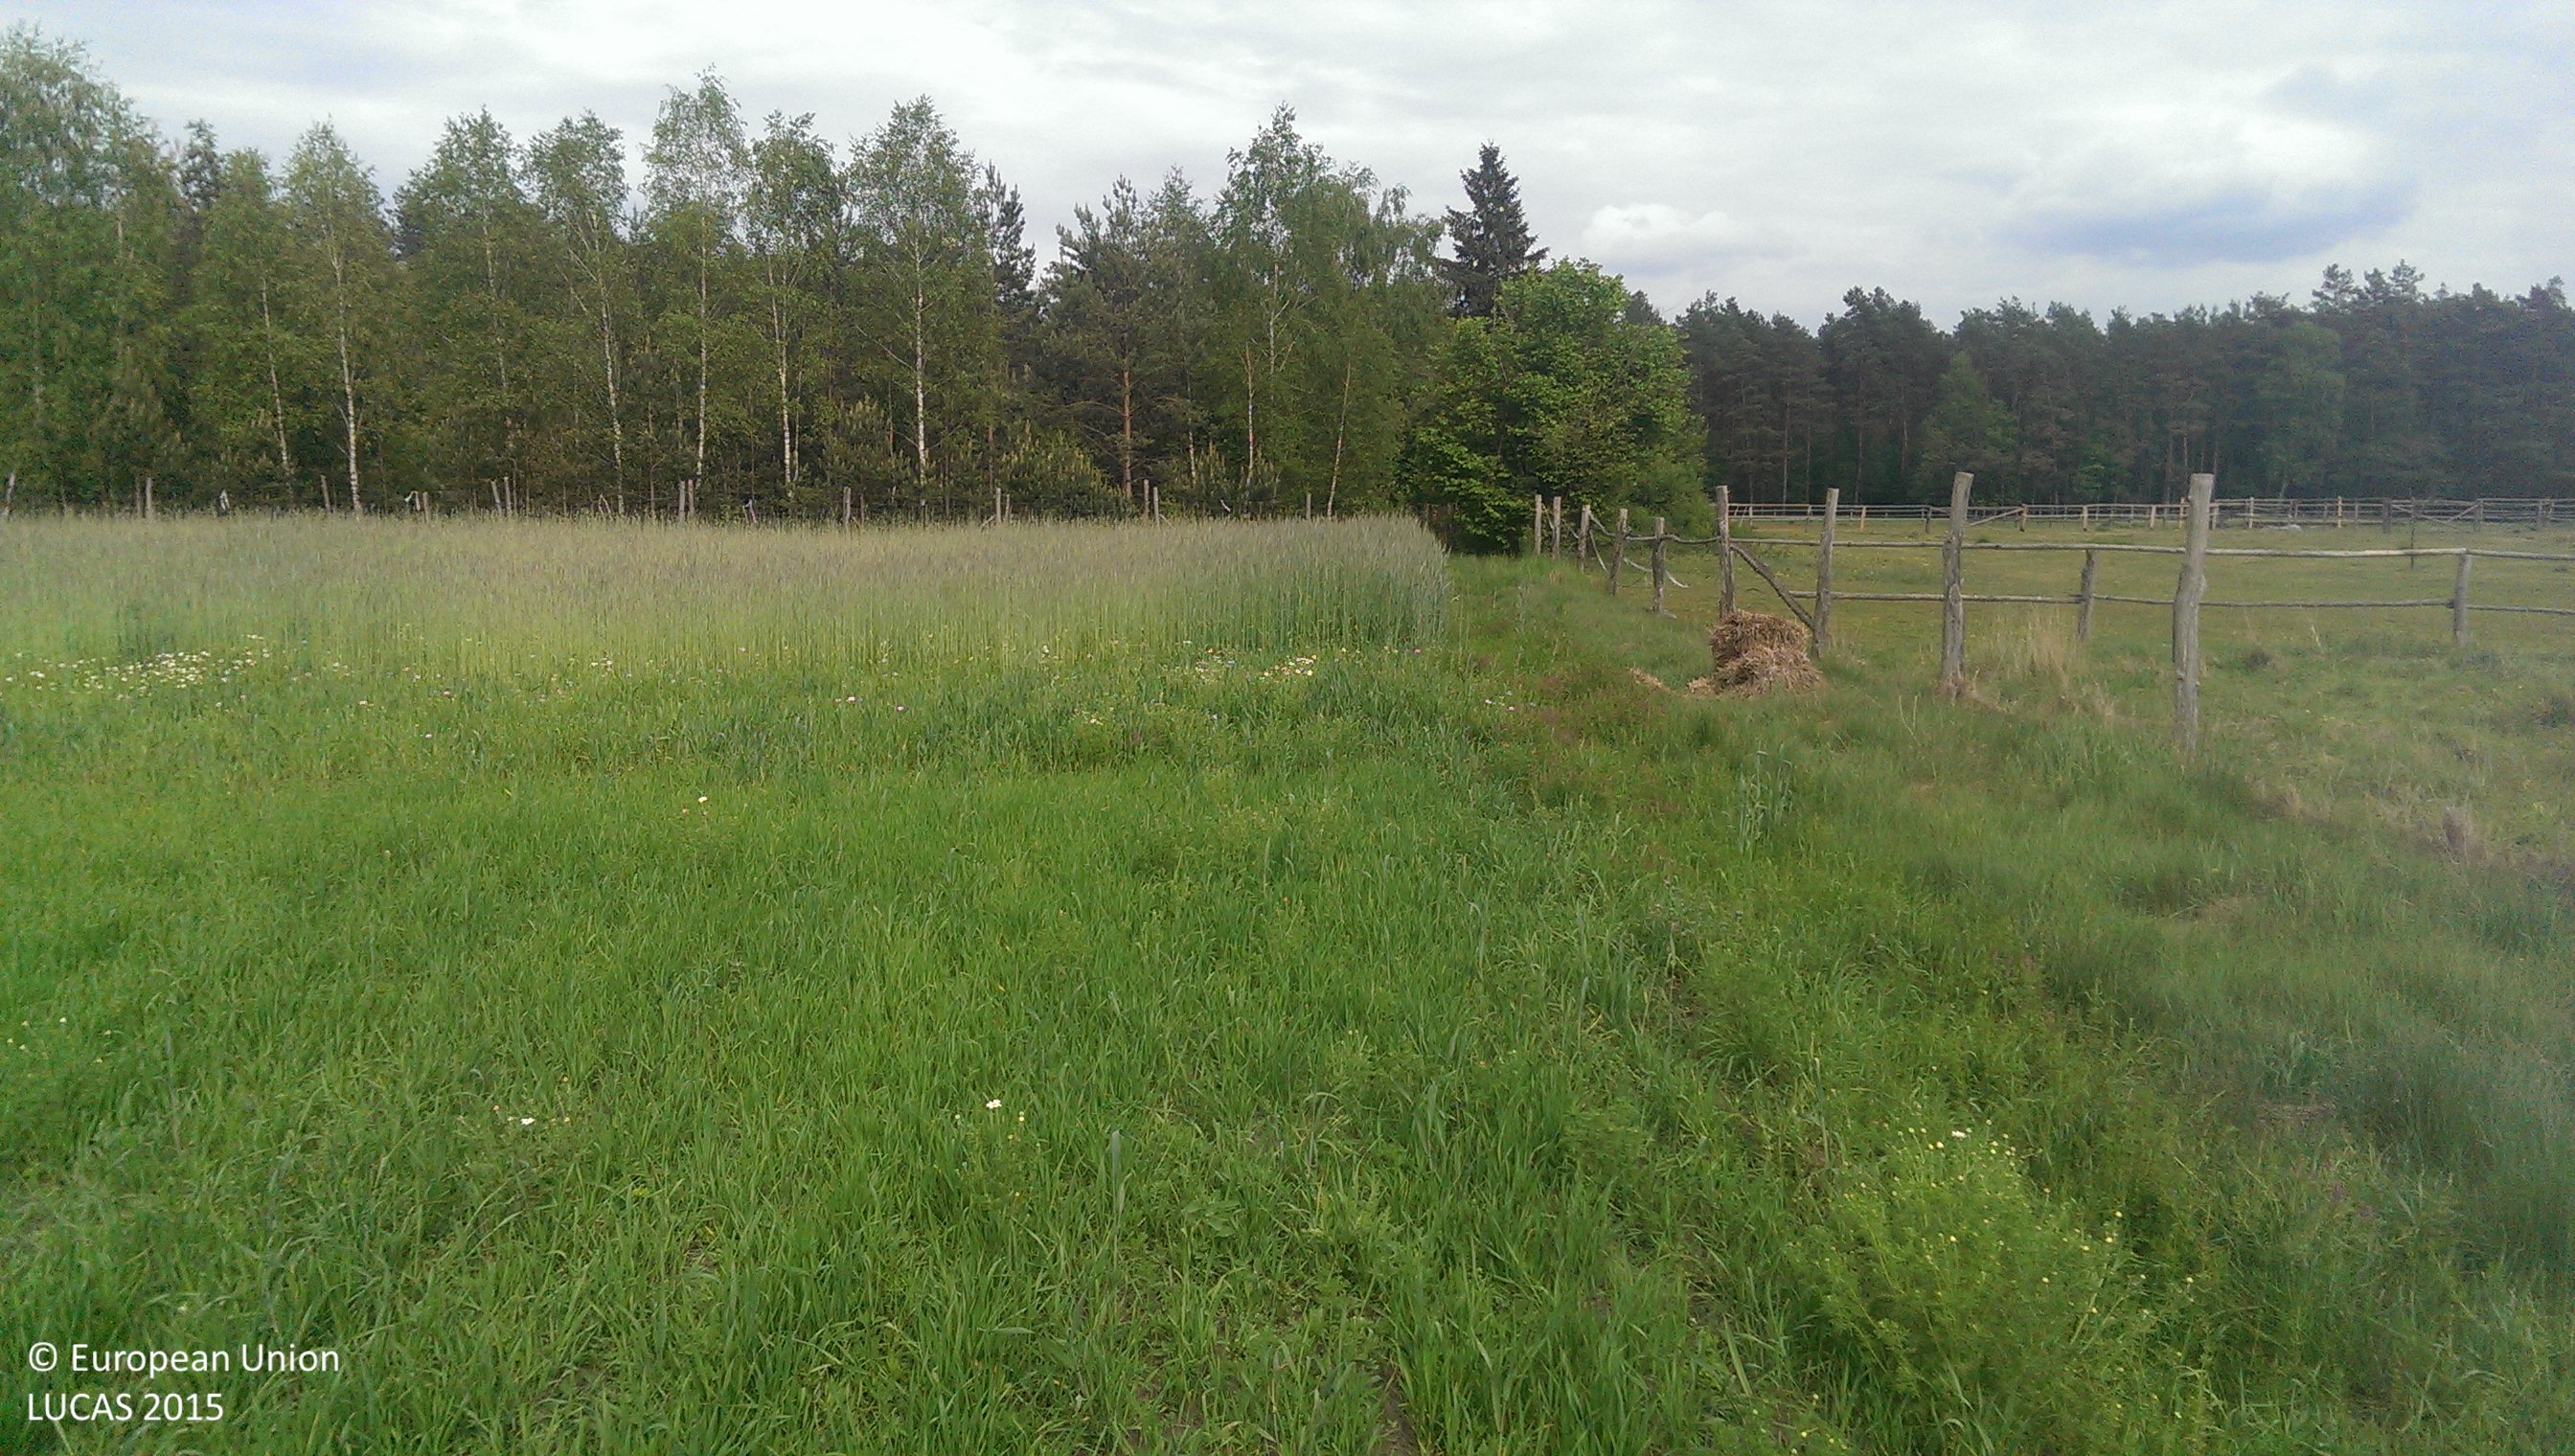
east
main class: Grassland
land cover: Grassland without tree/shrub cover
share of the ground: > 75 %
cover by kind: herbaceous plants 100 %
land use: Agriculture (excluding fallow land and kitchen gardens)
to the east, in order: Grassland without tree/shrub cover; Fences; Rye; Fences; Broadleaved woodland; Pine dominated mixed woodland; Spruce dominated coniferous woodland
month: May
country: PL
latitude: 52.3199
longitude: 16.2711
